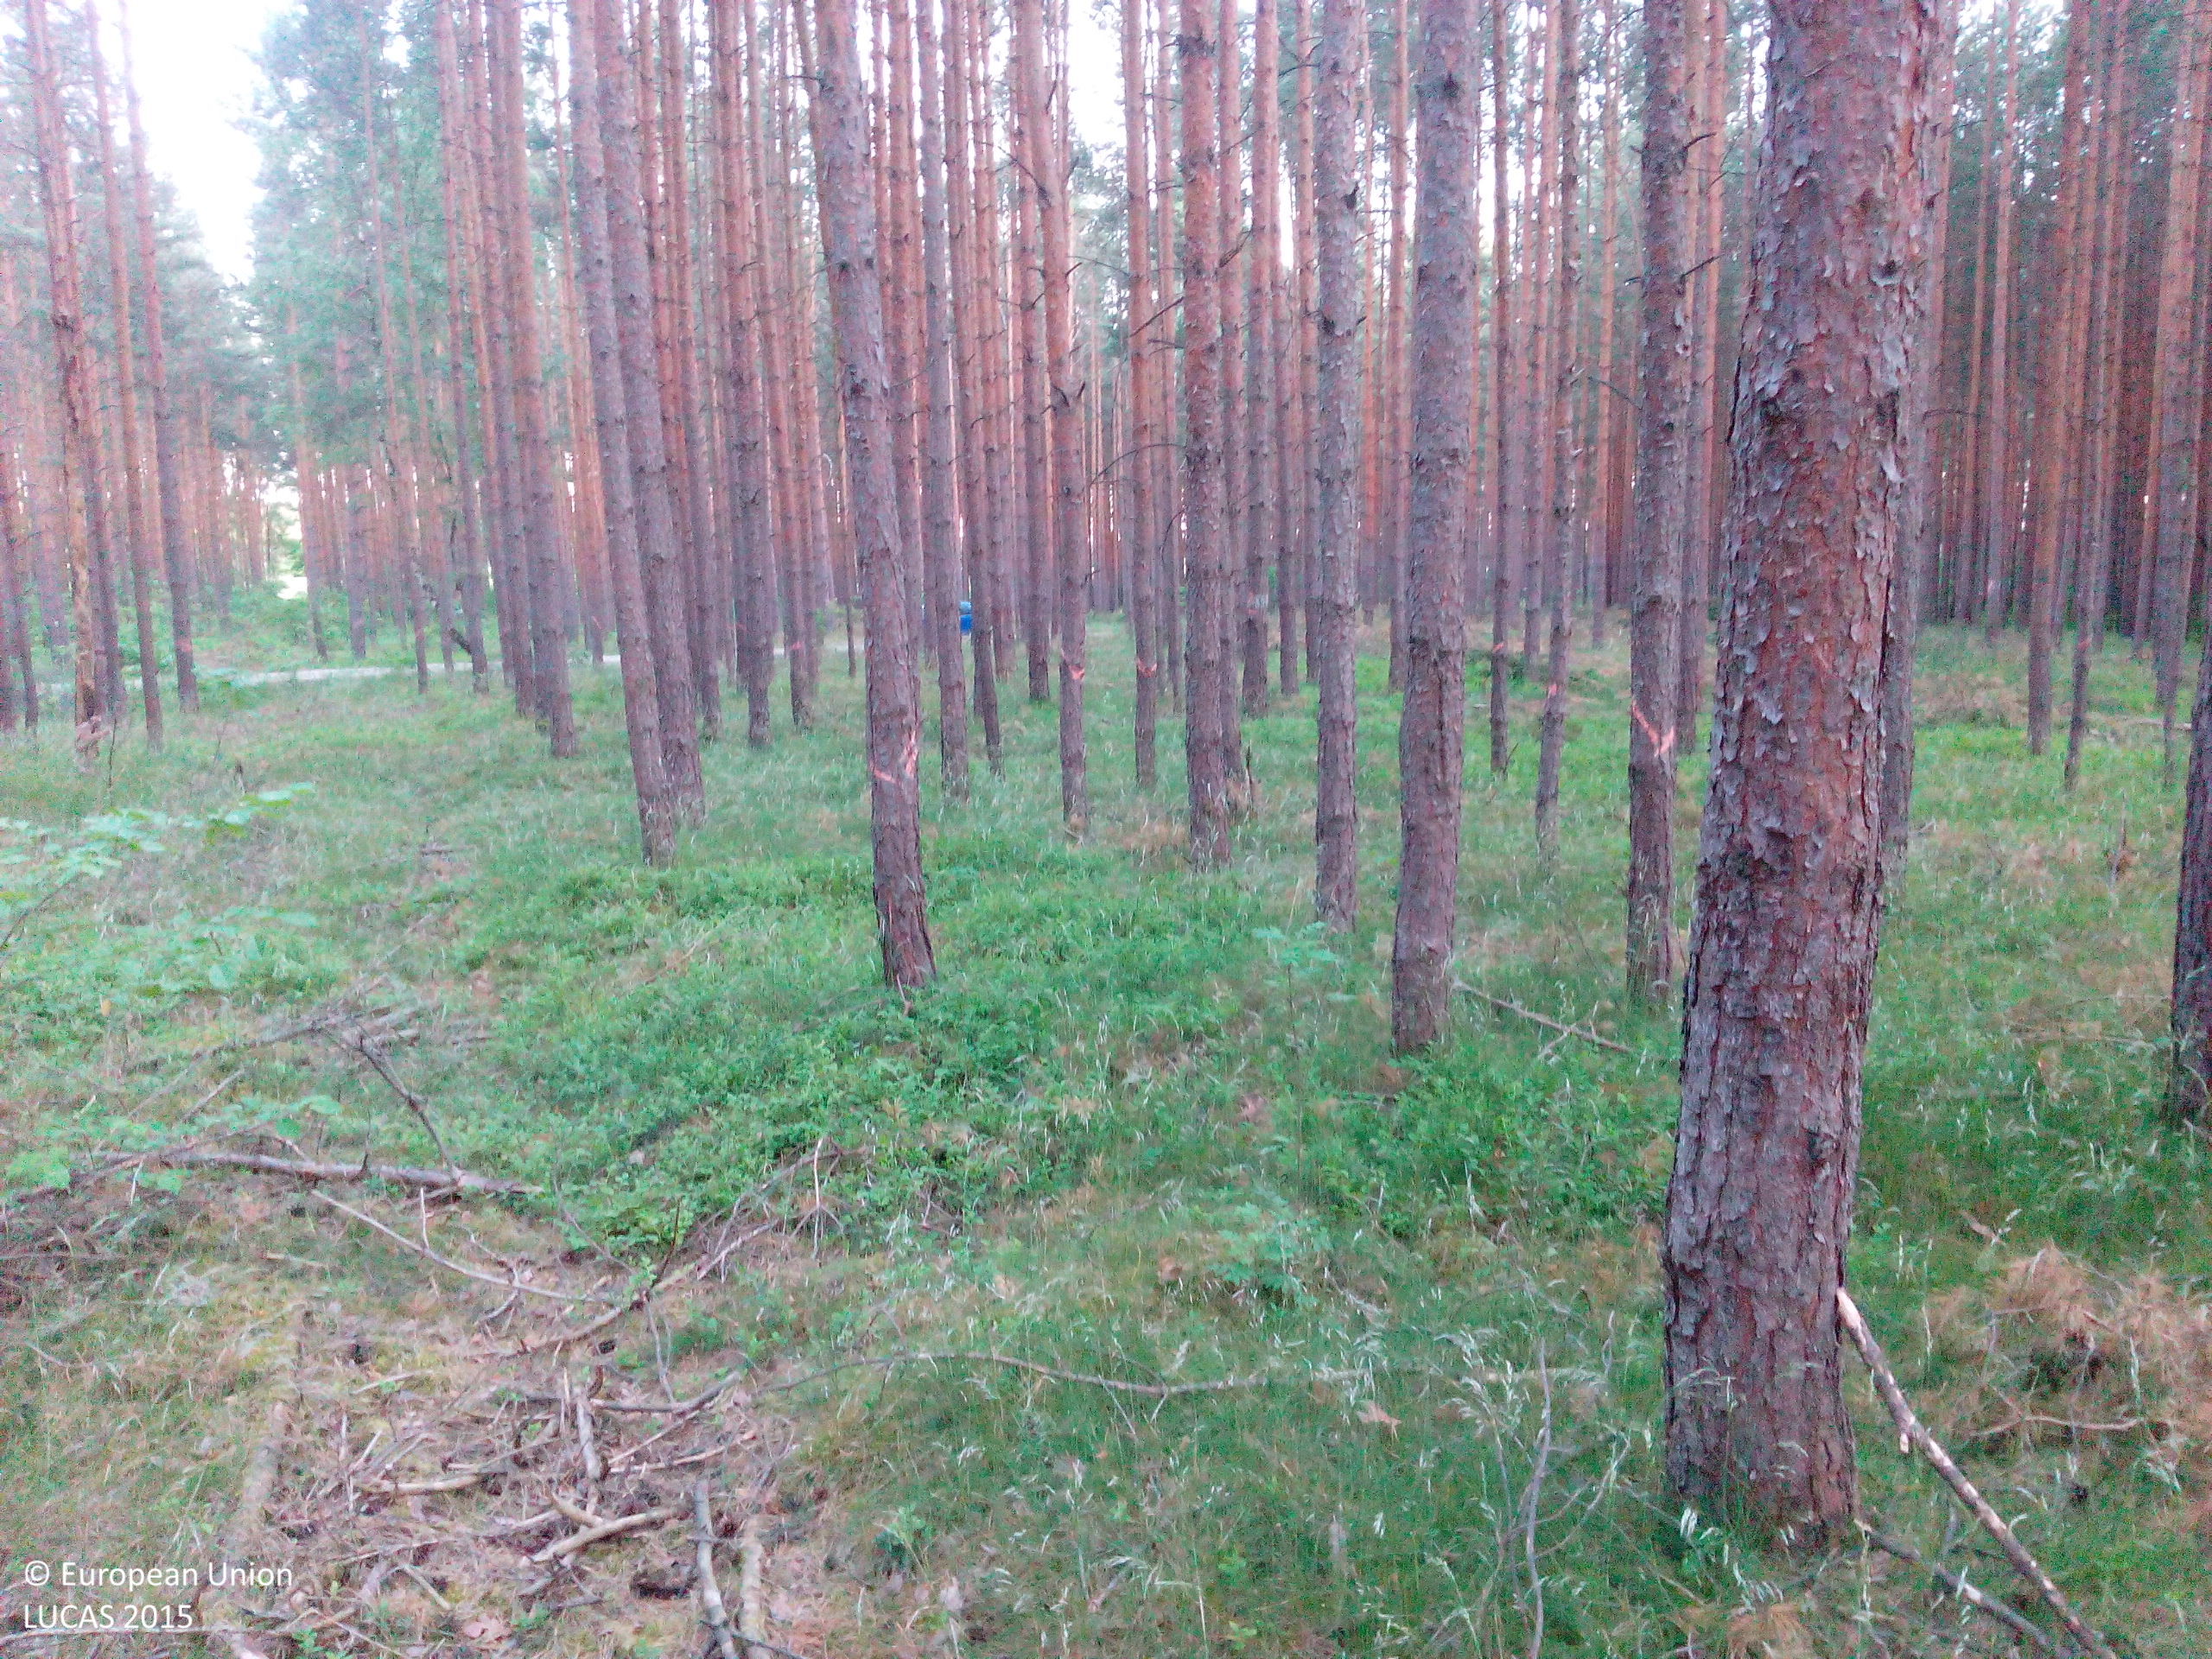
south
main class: Woodland
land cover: Pine dominated coniferous woodland
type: hemiboreal forest and nemoral coniferous forest and mixed broadleaved-coniferous forest
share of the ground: > 75 %
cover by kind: coniferous forest trees 90 %, shrubs 5 %, herbaceous plants 5 %
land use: Forestry
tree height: > 5 m
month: June
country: DE
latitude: 51.5538
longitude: 13.4473
